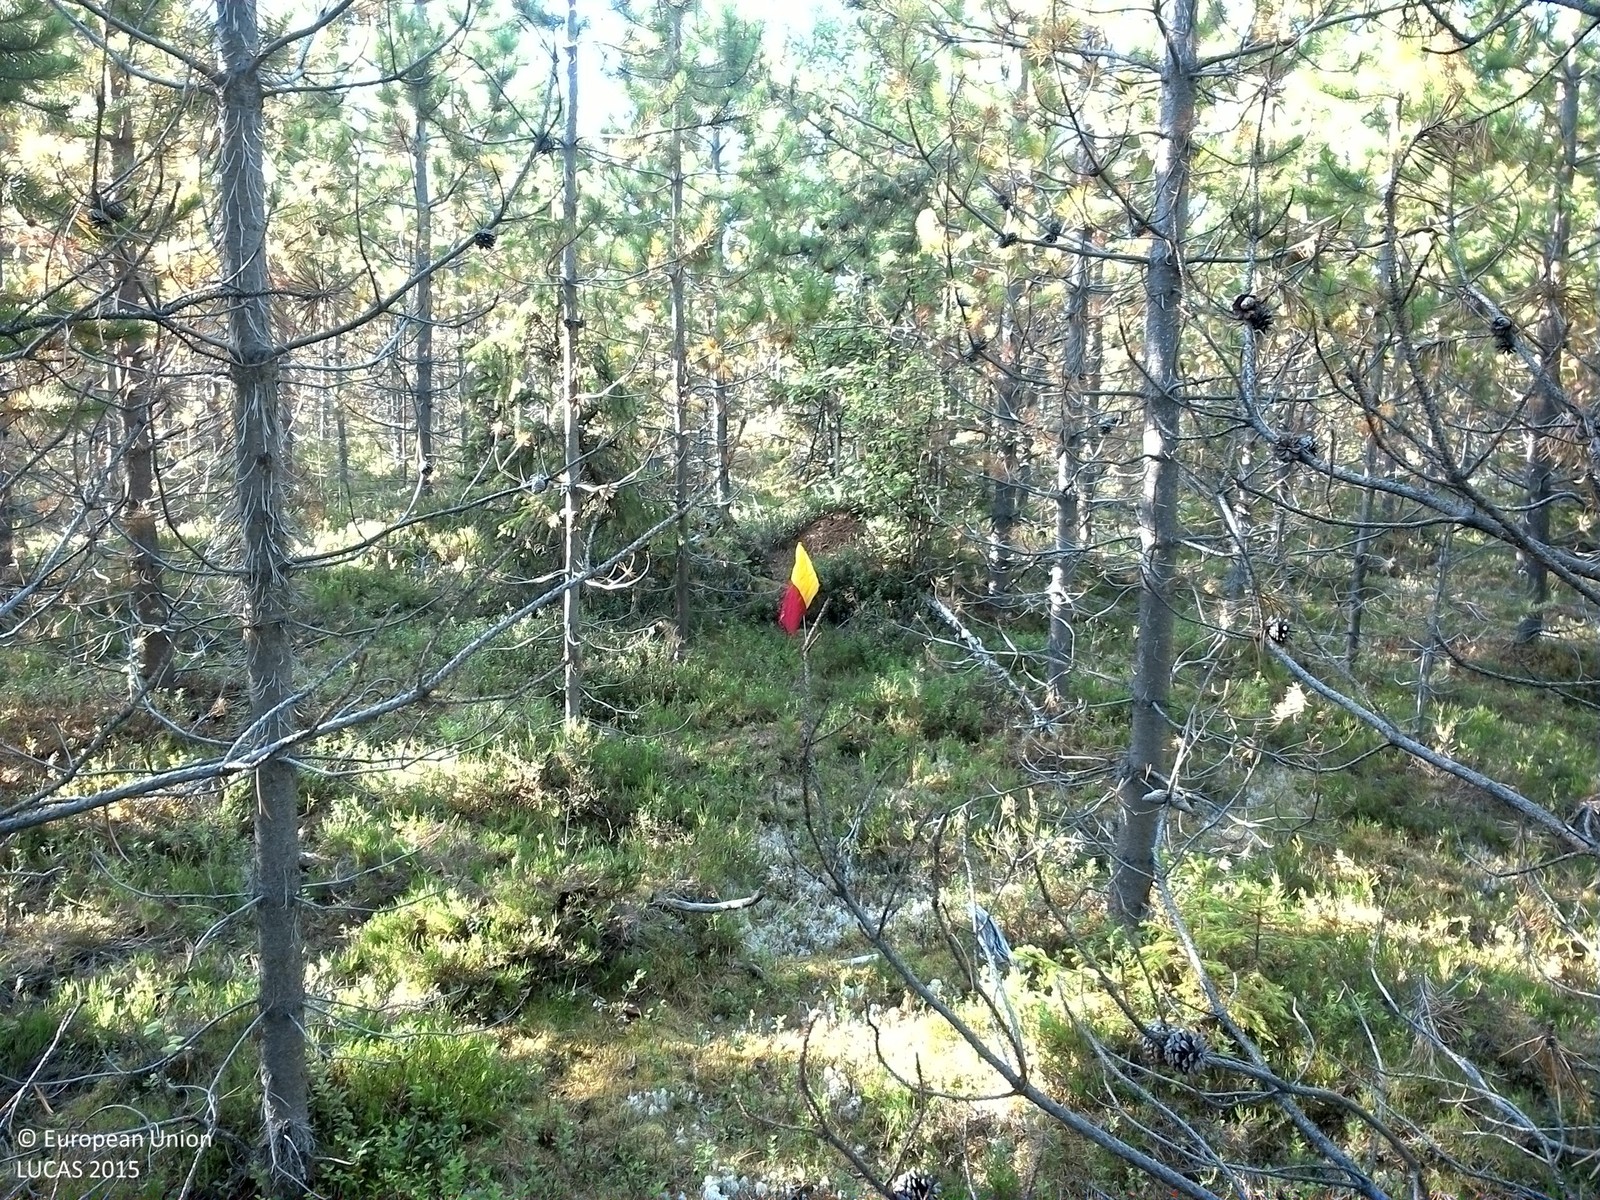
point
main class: Woodland
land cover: Pine dominated coniferous woodland
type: exotic forest
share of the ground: 50 - 75 %
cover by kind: coniferous forest trees 50 %, shrubs 25 %, lichens and mosses 15 %, broadleaved forest trees 5 %, consolidated bare surface 5 %
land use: Forestry
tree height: > 5 m
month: August
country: SE
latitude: 63.9098
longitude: 16.7578
